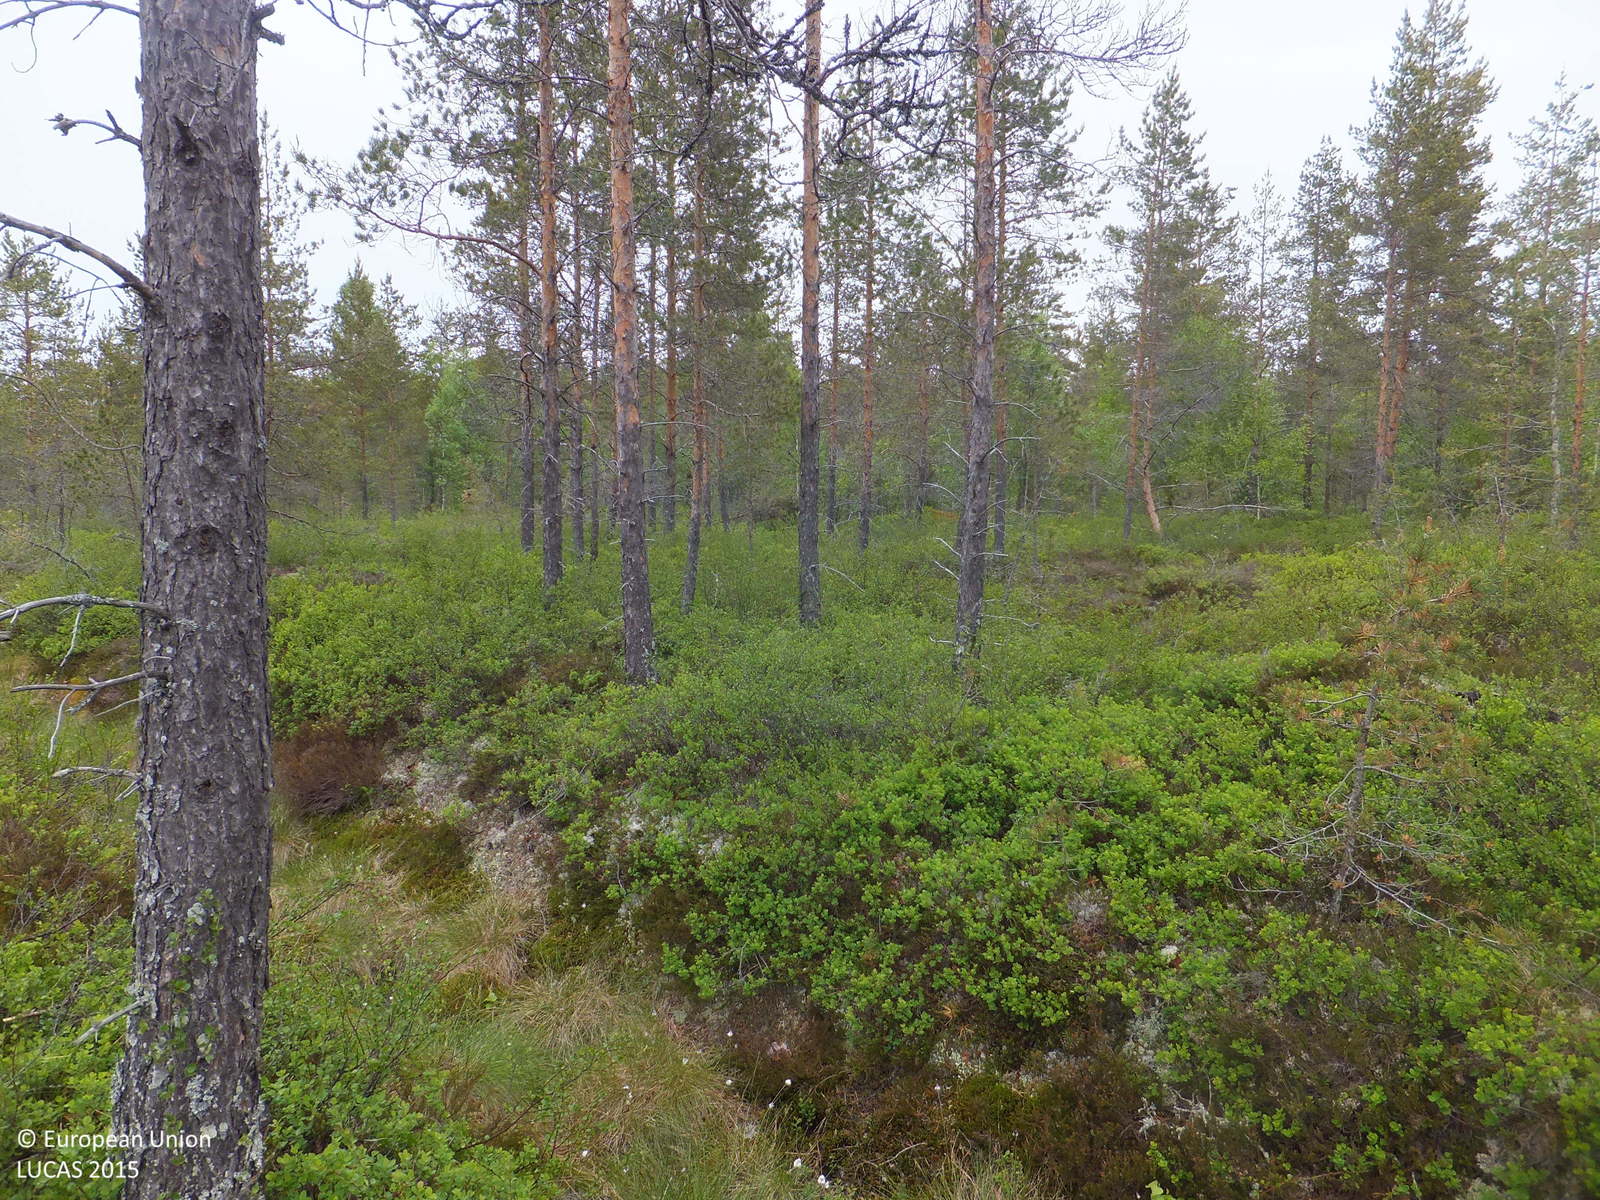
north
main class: Woodland
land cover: Pine dominated coniferous woodland
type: boreal forest
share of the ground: 25 - 50 %
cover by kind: coniferous forest trees 40 %, shrubs 40 %, herbaceous plants 20 %
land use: Forestry
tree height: > 5 m
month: June
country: FI
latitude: 63.6461
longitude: 24.1859
